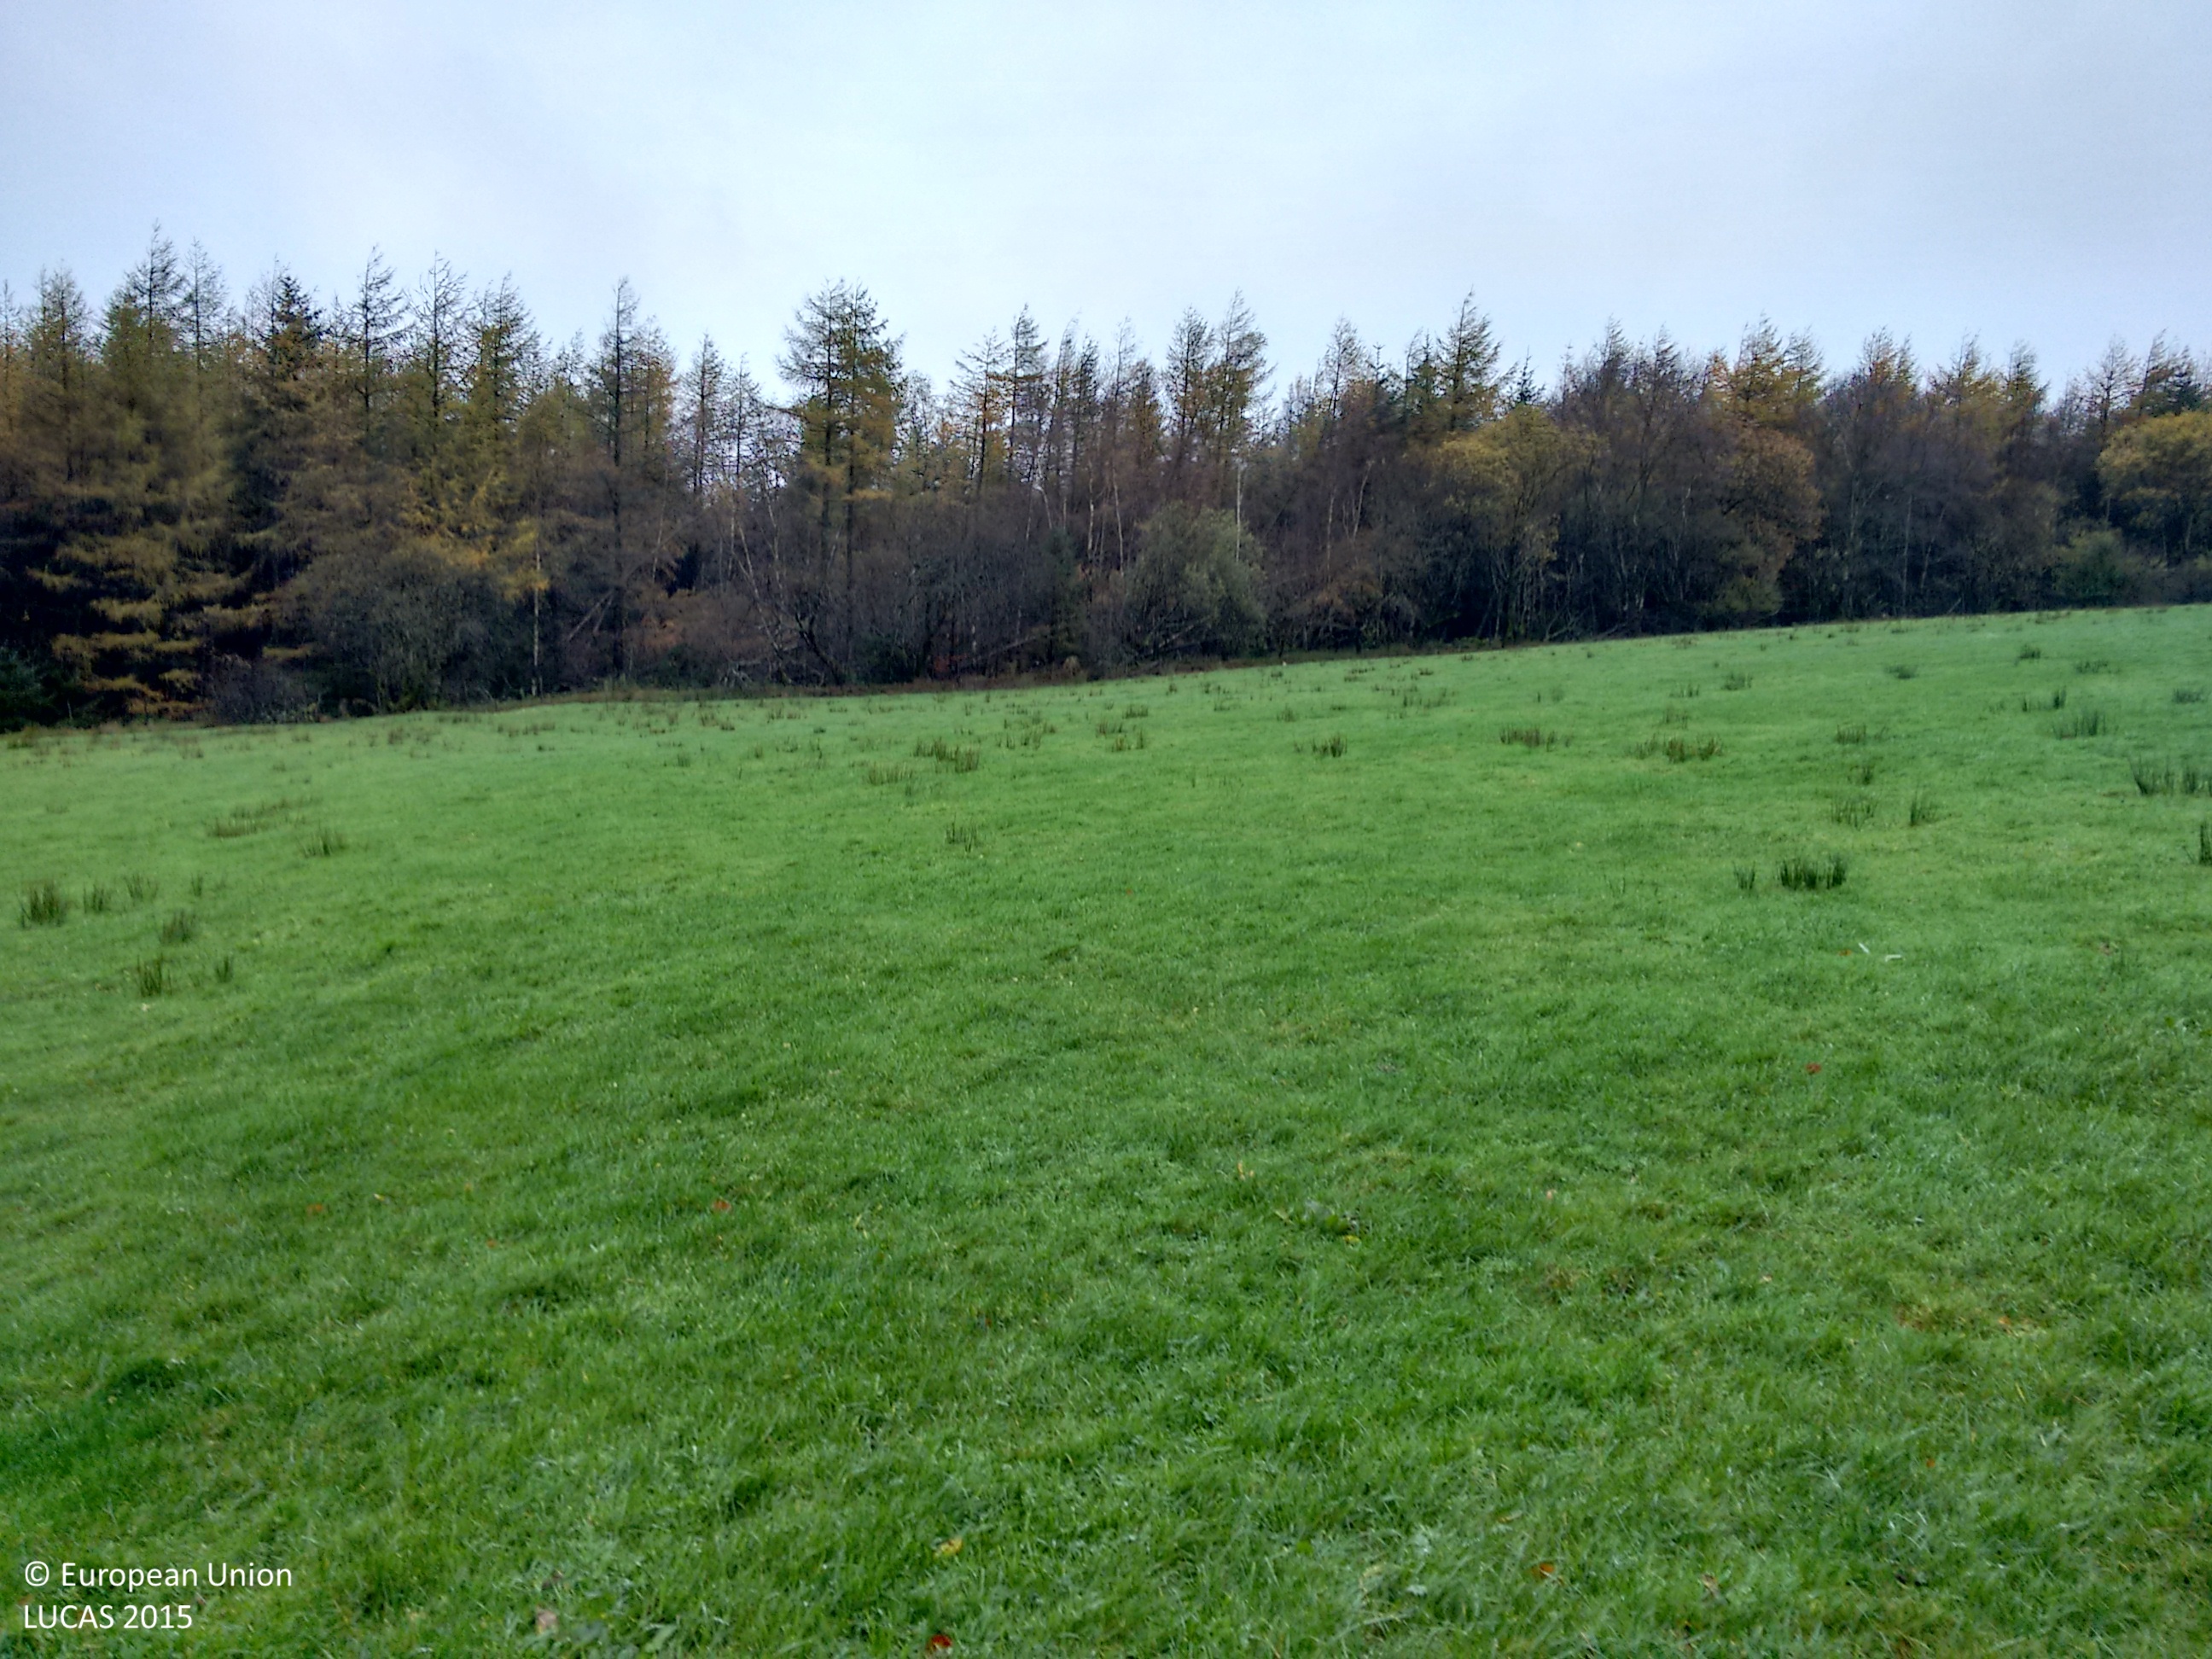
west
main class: Grassland
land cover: Grassland without tree/shrub cover
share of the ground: > 75 %
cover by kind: herbaceous plants 100 %
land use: Agriculture (excluding fallow land and kitchen gardens)
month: November
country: GB
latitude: 54.5299
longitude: -3.4159
